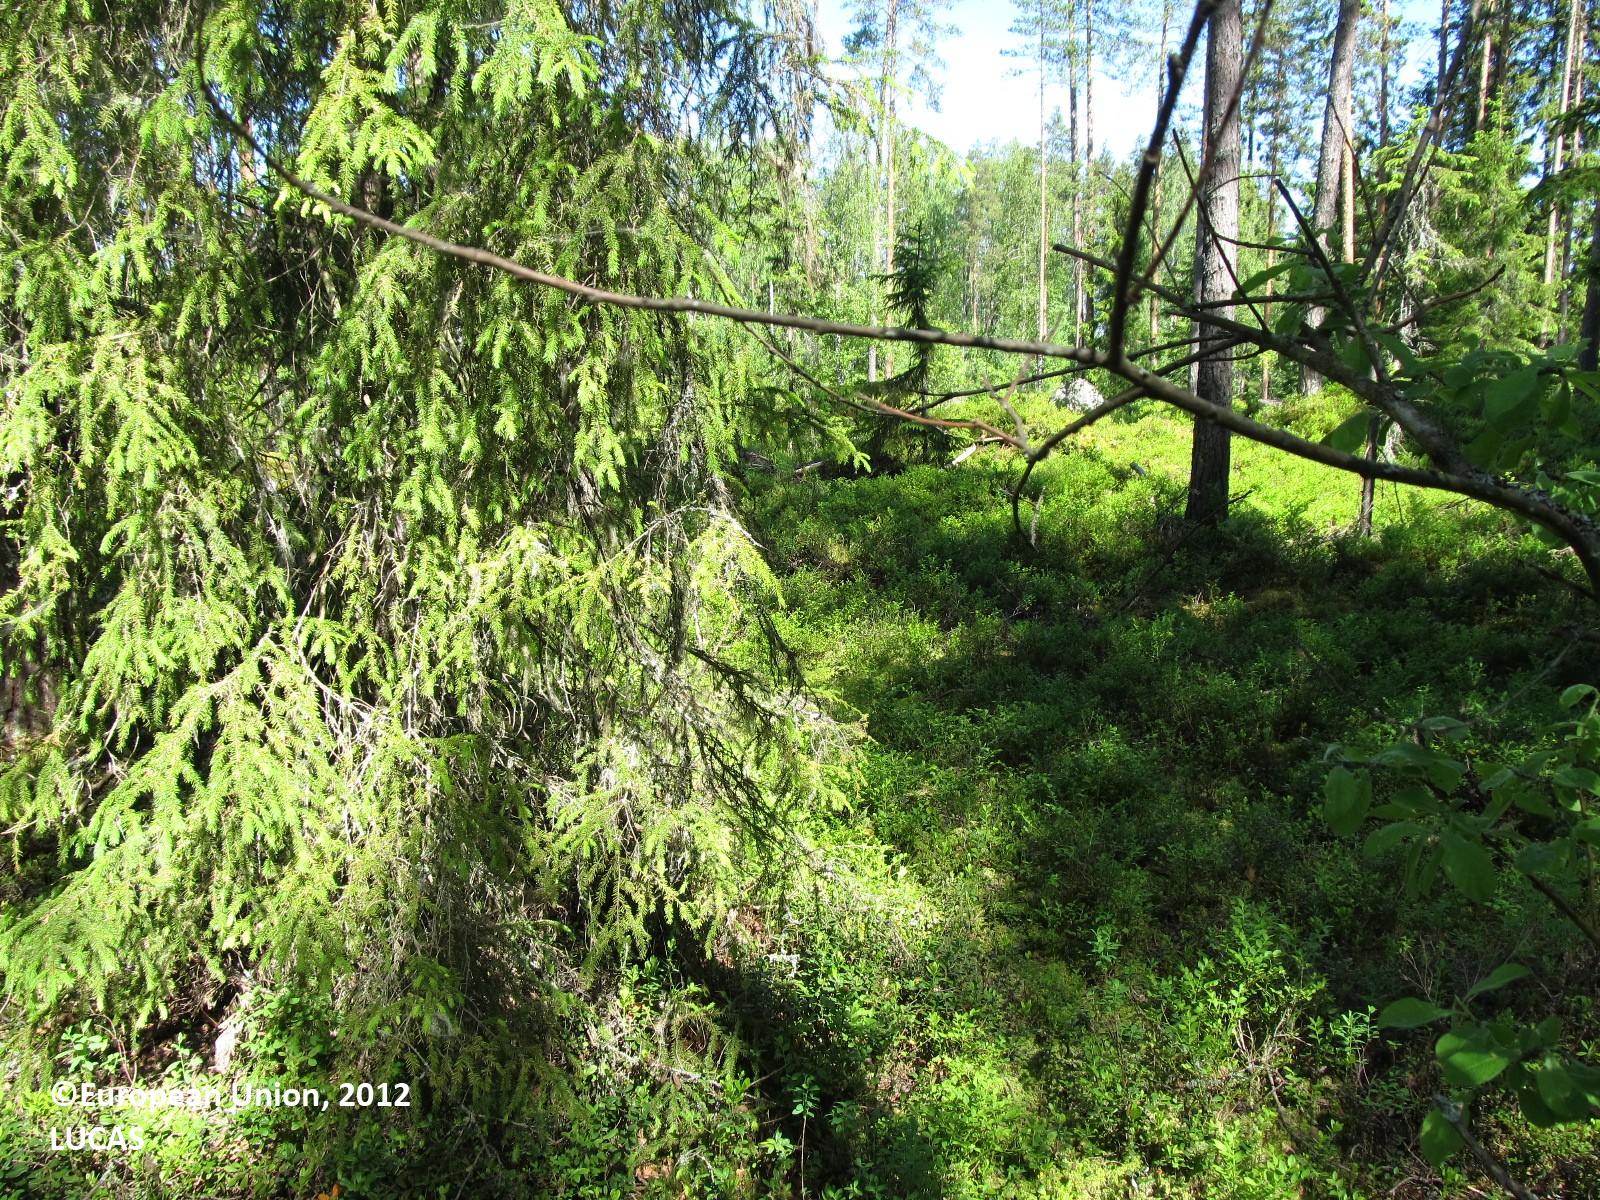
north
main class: Woodland
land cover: Other coniferous woodland
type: boreal forest
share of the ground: 25 - 50 %
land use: Forestry
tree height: > 5 m
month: June
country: FI
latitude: 62.9925
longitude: 27.7571
